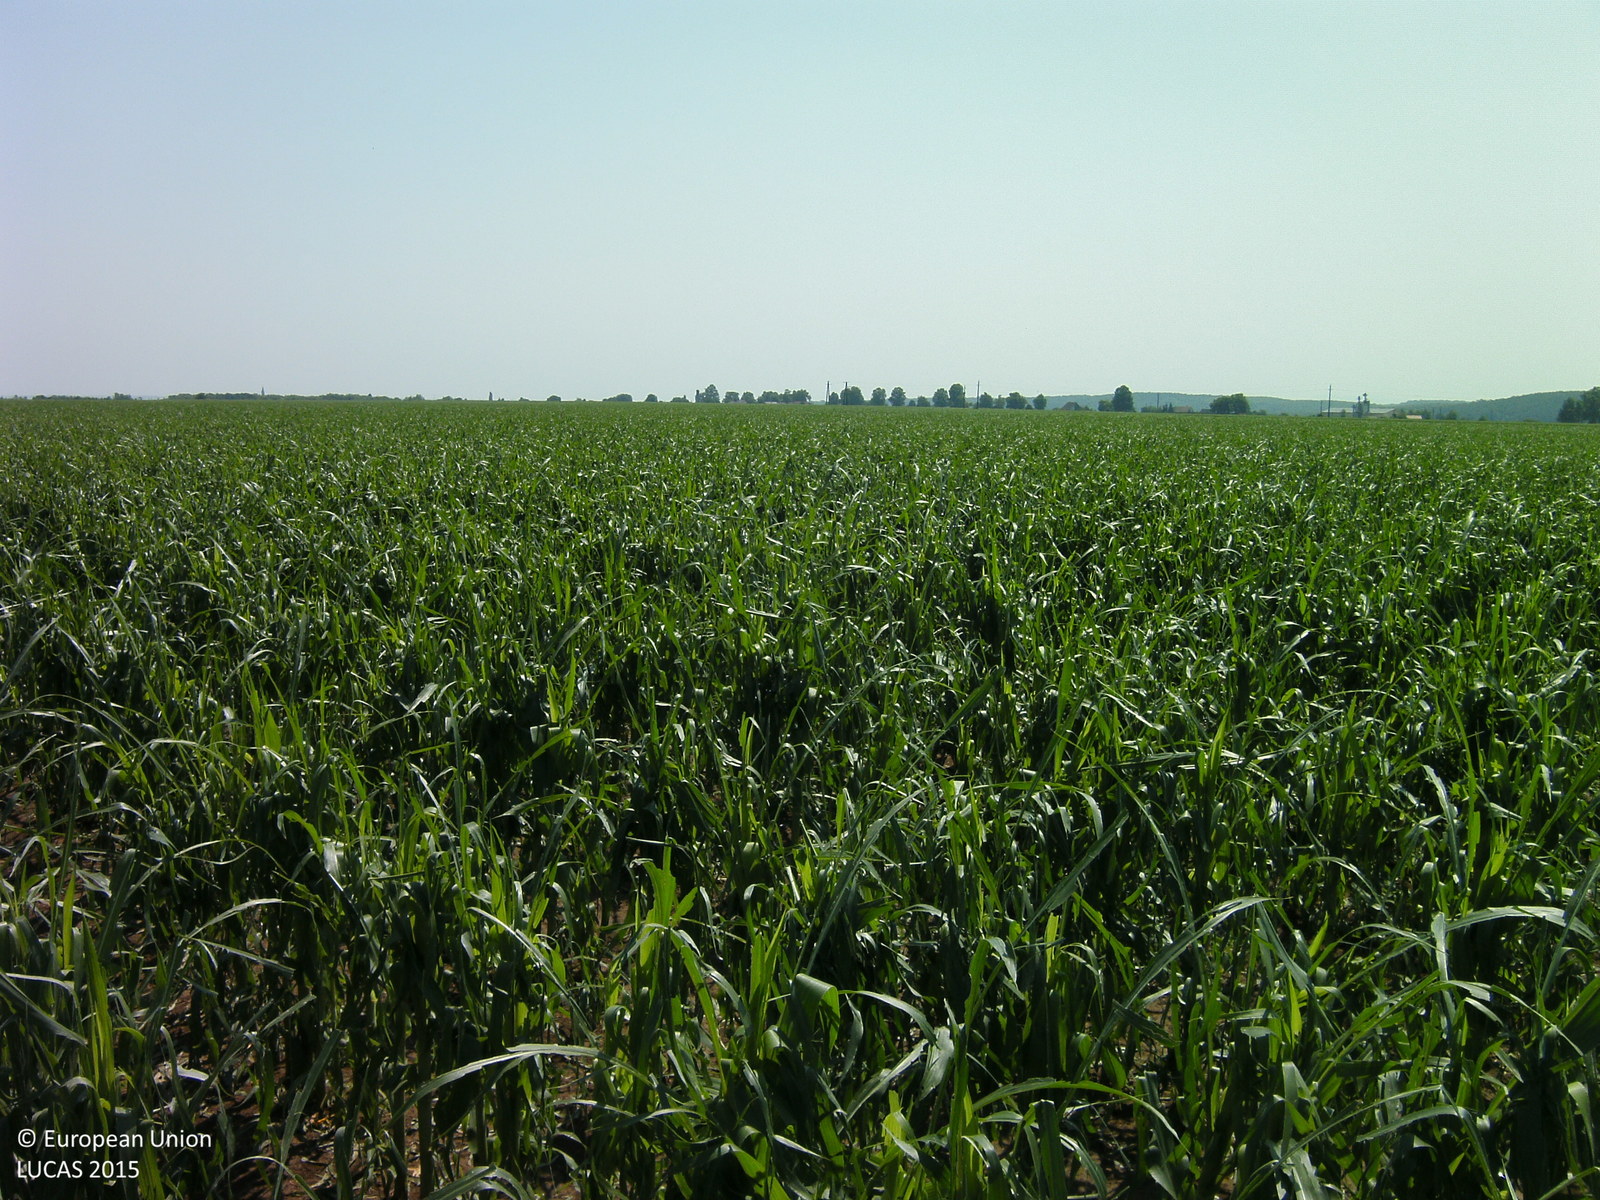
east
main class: Cropland
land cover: Maize
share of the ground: 50 - 75 %
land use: Agriculture (excluding fallow land and kitchen gardens)
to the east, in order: Maize
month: June
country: HU
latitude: 46.3748
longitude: 18.0284
